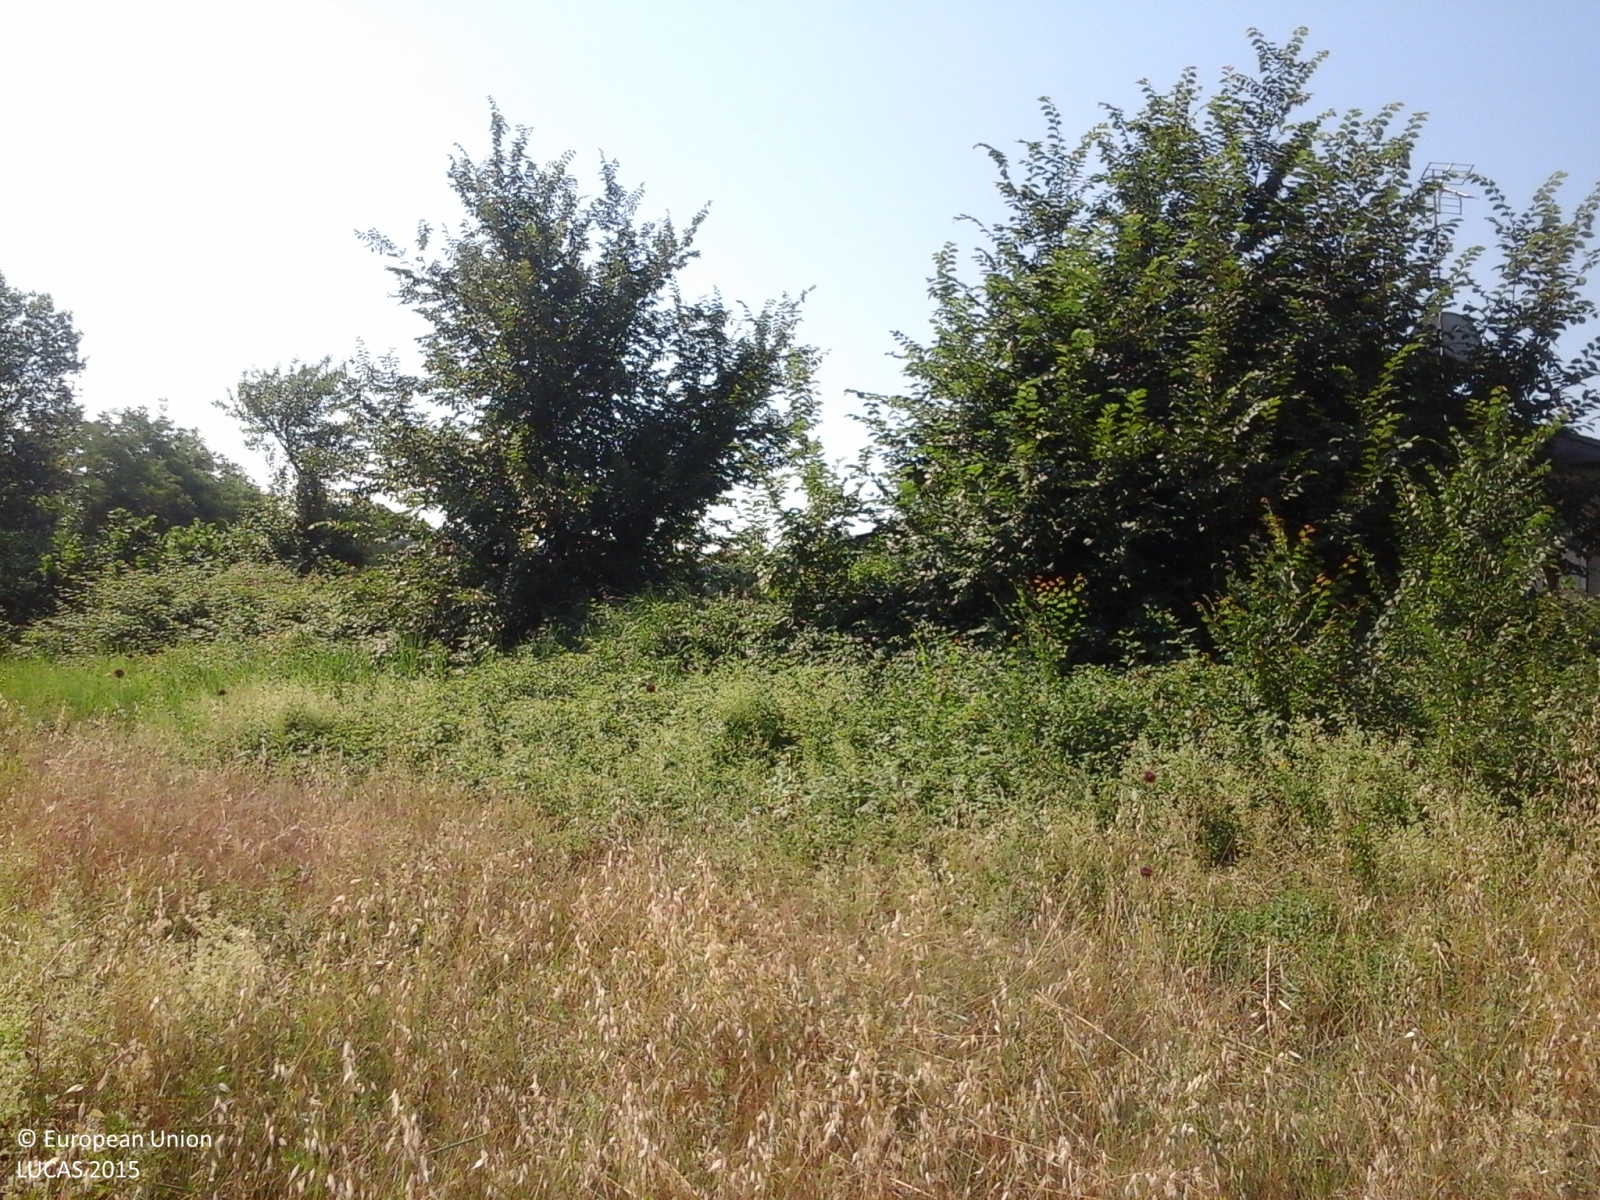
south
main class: Grassland
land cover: Grassland without tree/shrub cover
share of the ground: > 75 %
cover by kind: herbaceous plants 100 %
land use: Agriculture (excluding fallow land and kitchen gardens)
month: May
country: IT
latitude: 41.6407
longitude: 13.3369
